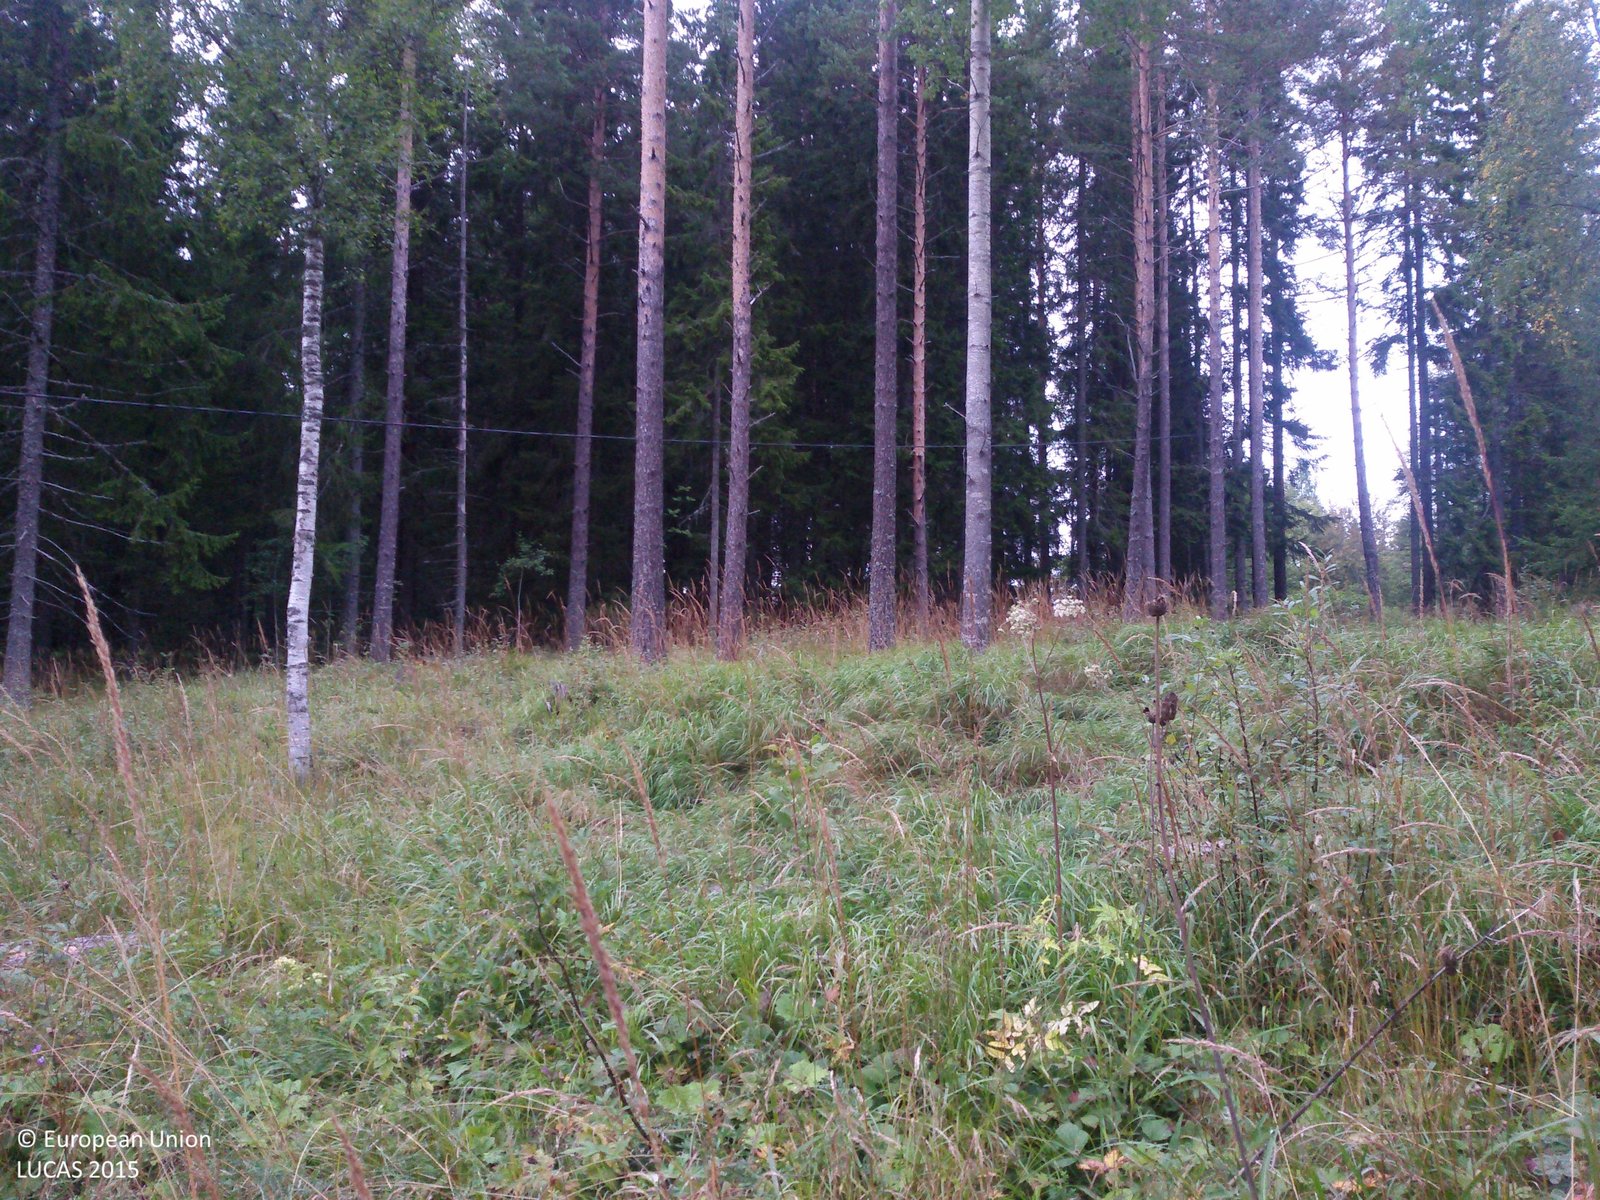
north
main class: Woodland
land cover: Pine dominated mixed woodland
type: boreal forest
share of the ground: 25 - 50 %
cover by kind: herbaceous plants 70 %, coniferous forest trees 15 %, broadleaved forest trees 15 %
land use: Forestry
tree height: > 5 m
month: September
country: SE
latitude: 60.8184
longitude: 15.3737
